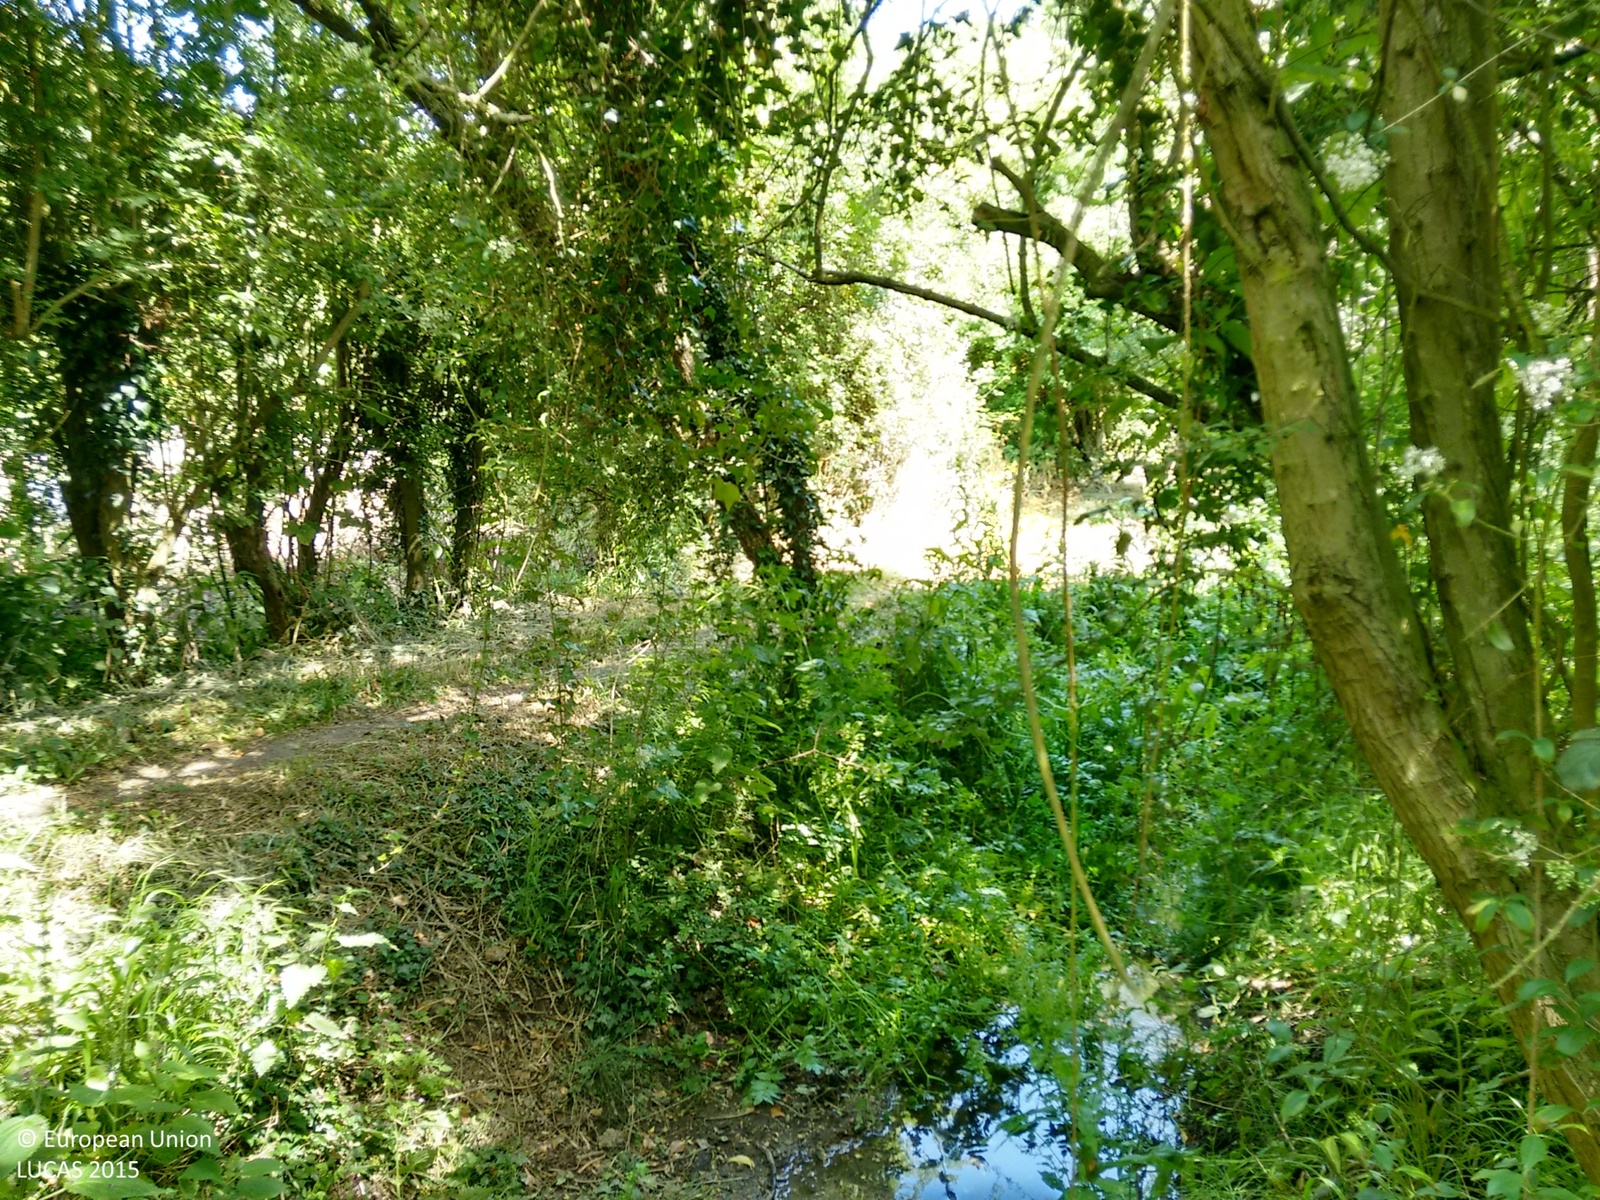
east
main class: Woodland
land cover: Broadleaved woodland
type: mesophytic deciduous forest
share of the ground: > 75 %
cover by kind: broadleaved forest trees 80 %, shrubs 10 %, herbaceous plants 10 %
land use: Semi-natural and natural areas not in use
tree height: > 5 m
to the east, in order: Broadleaved woodland; Ditches and canals; Grass margins; Tracks; Broadleaved woodland; Fences; Nurseries; Fences; Broadleaved woodland; Tracks; Broadleaved woodland; Fences; Broadleaved woodland; Fences; Grassland without tree/shrub cover; Managed hedges; Grassland without tree/shrub cover; Managed hedges; Grass margins; Paved roads, cycling and walking lanes; Managed hedges; Fences; Grassland without tree/shrub cover
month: July
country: GB
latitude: 51.6373
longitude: -1.0993
